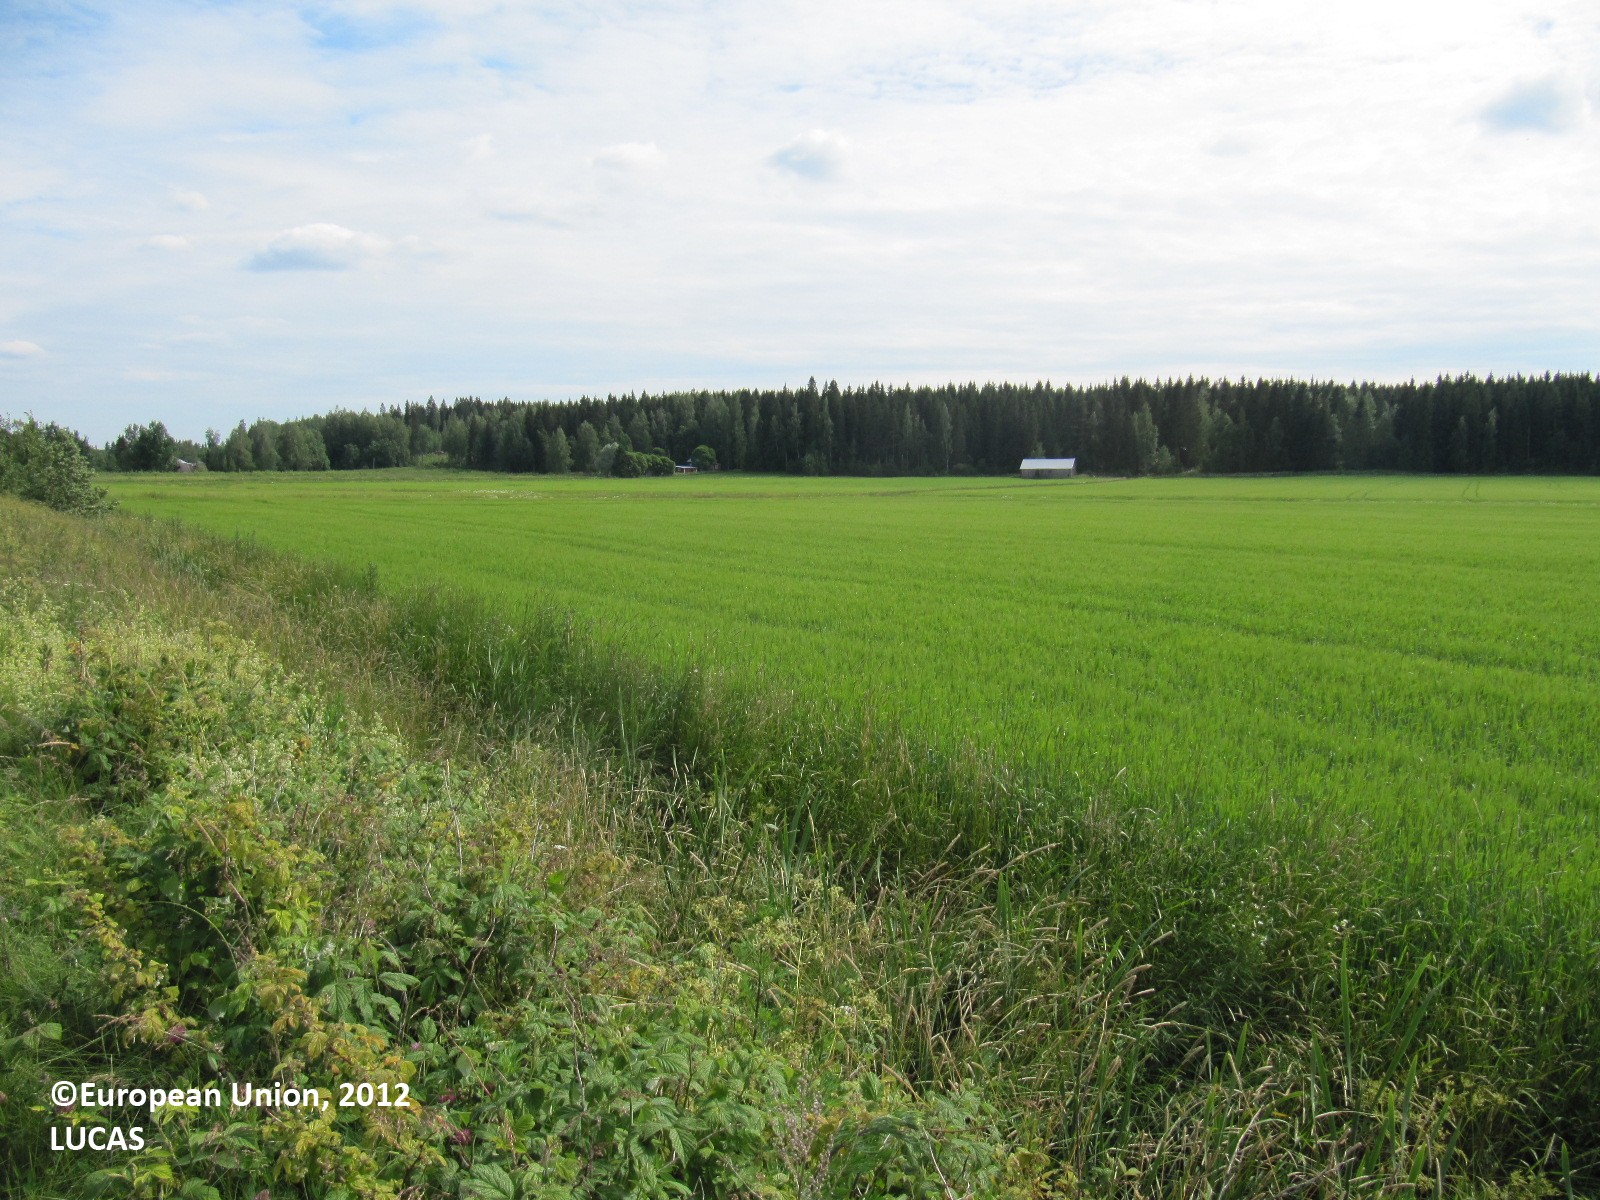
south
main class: Cropland
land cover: Barley
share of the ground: > 75 %
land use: Agriculture (excluding fallow land and kitchen gardens)
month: July
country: FI
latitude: 60.8915
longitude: 23.4057
